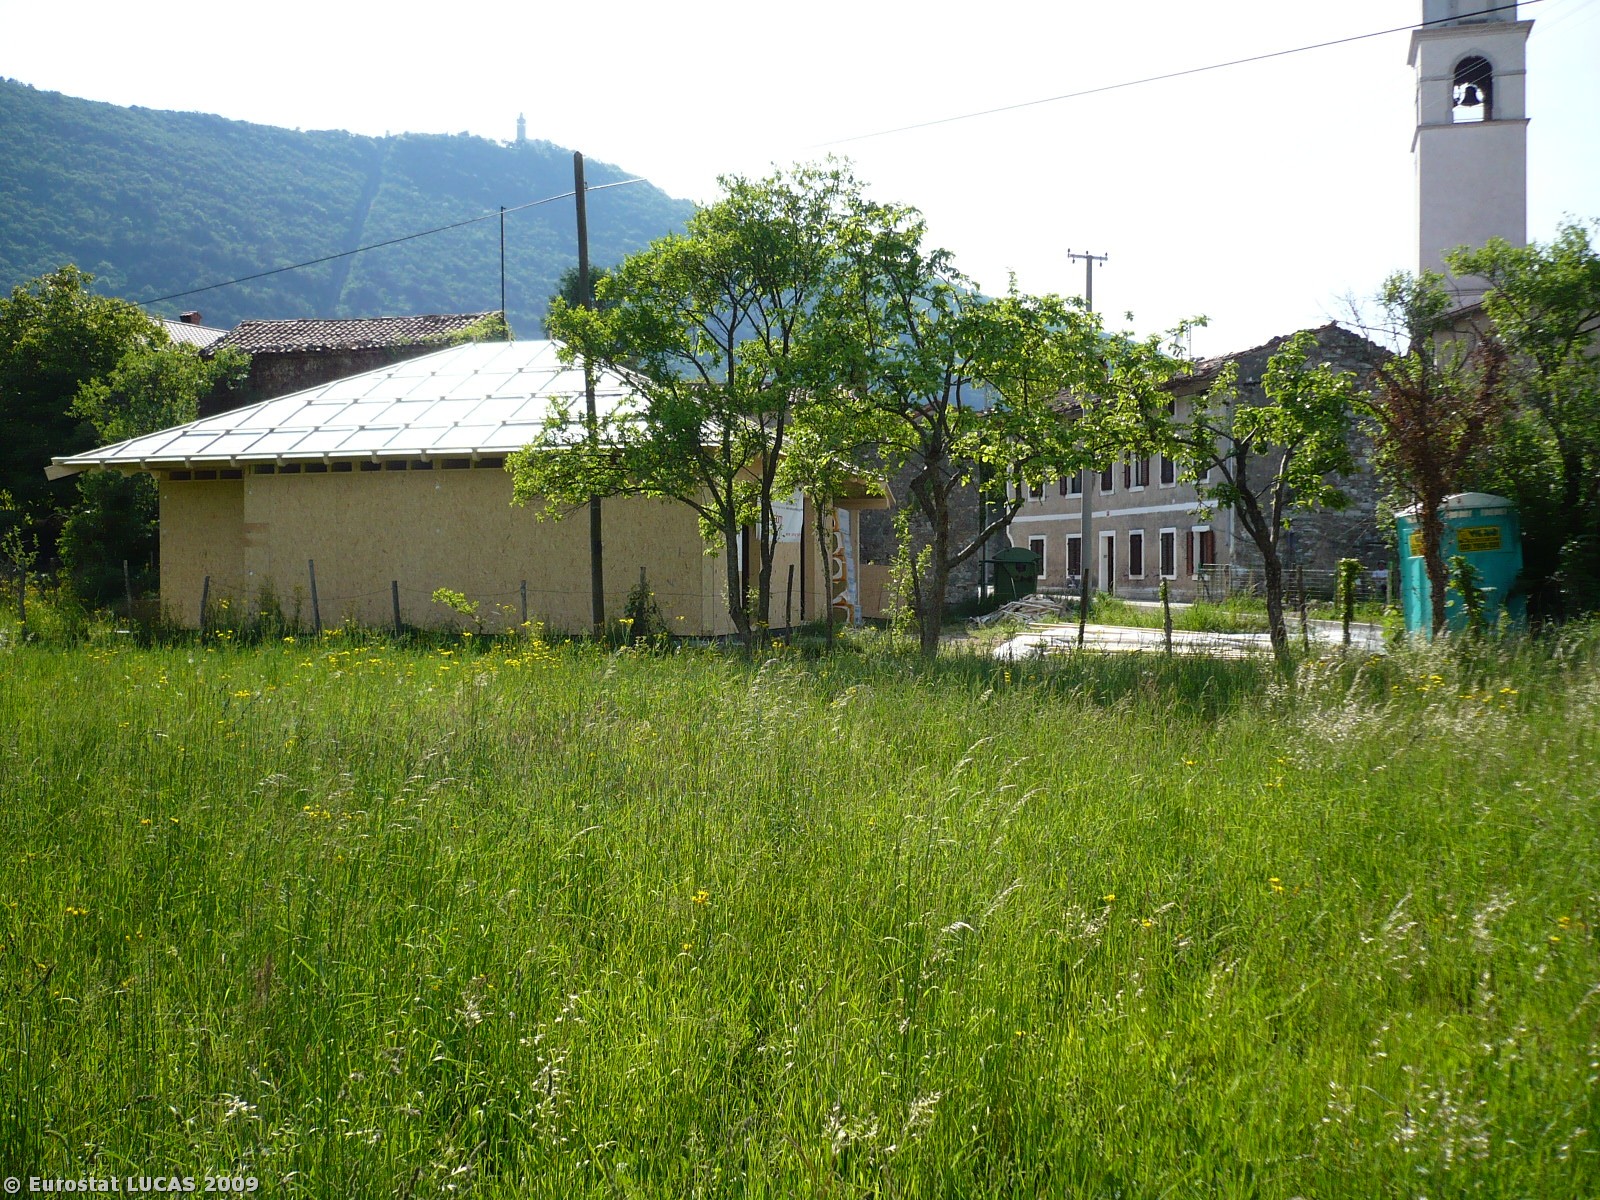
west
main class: Grassland
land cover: Grassland without tree/shrub cover
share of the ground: > 75 %
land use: Agriculture (excluding fallow land and kitchen gardens)
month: May
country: SI
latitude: 45.9995
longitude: 13.6762
